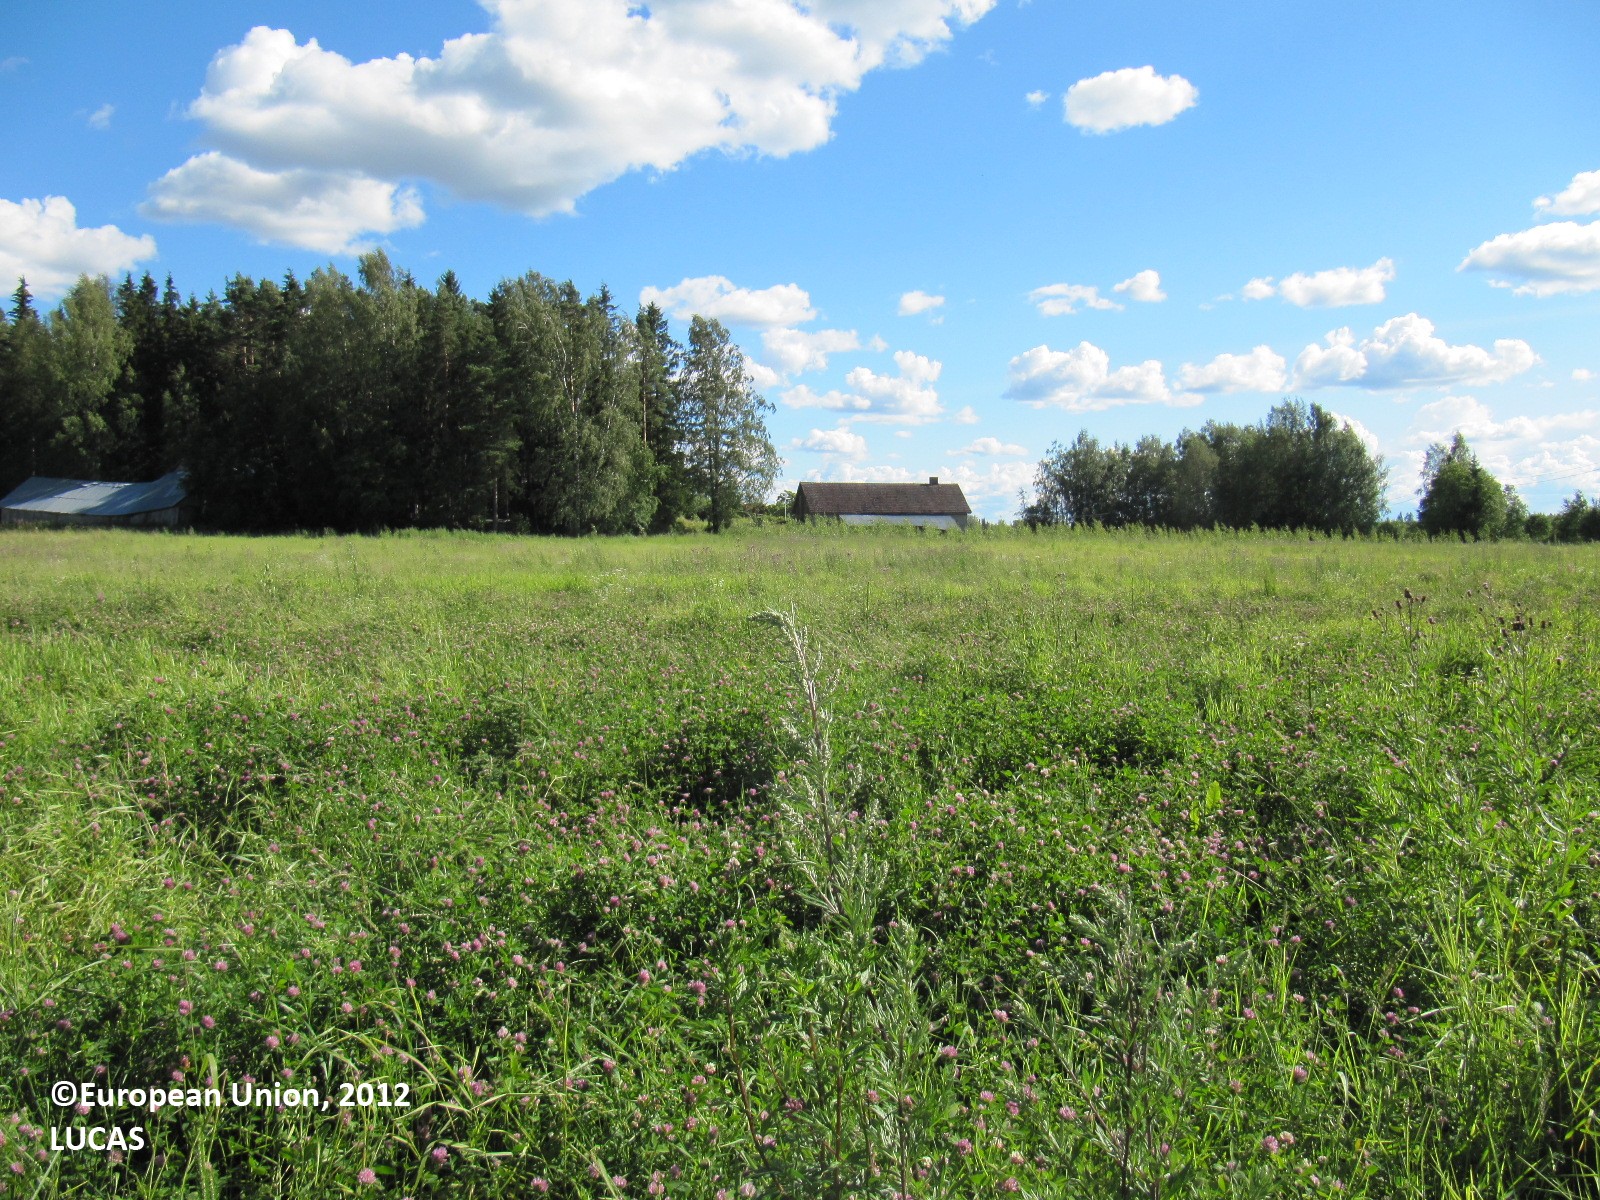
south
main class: Woodland
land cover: Spruce dominated coniferous woodland
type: boreal forest
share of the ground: 10 - 25 %
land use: Forestry
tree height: < 5 m
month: July
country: FI
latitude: 60.8843
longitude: 24.4171
